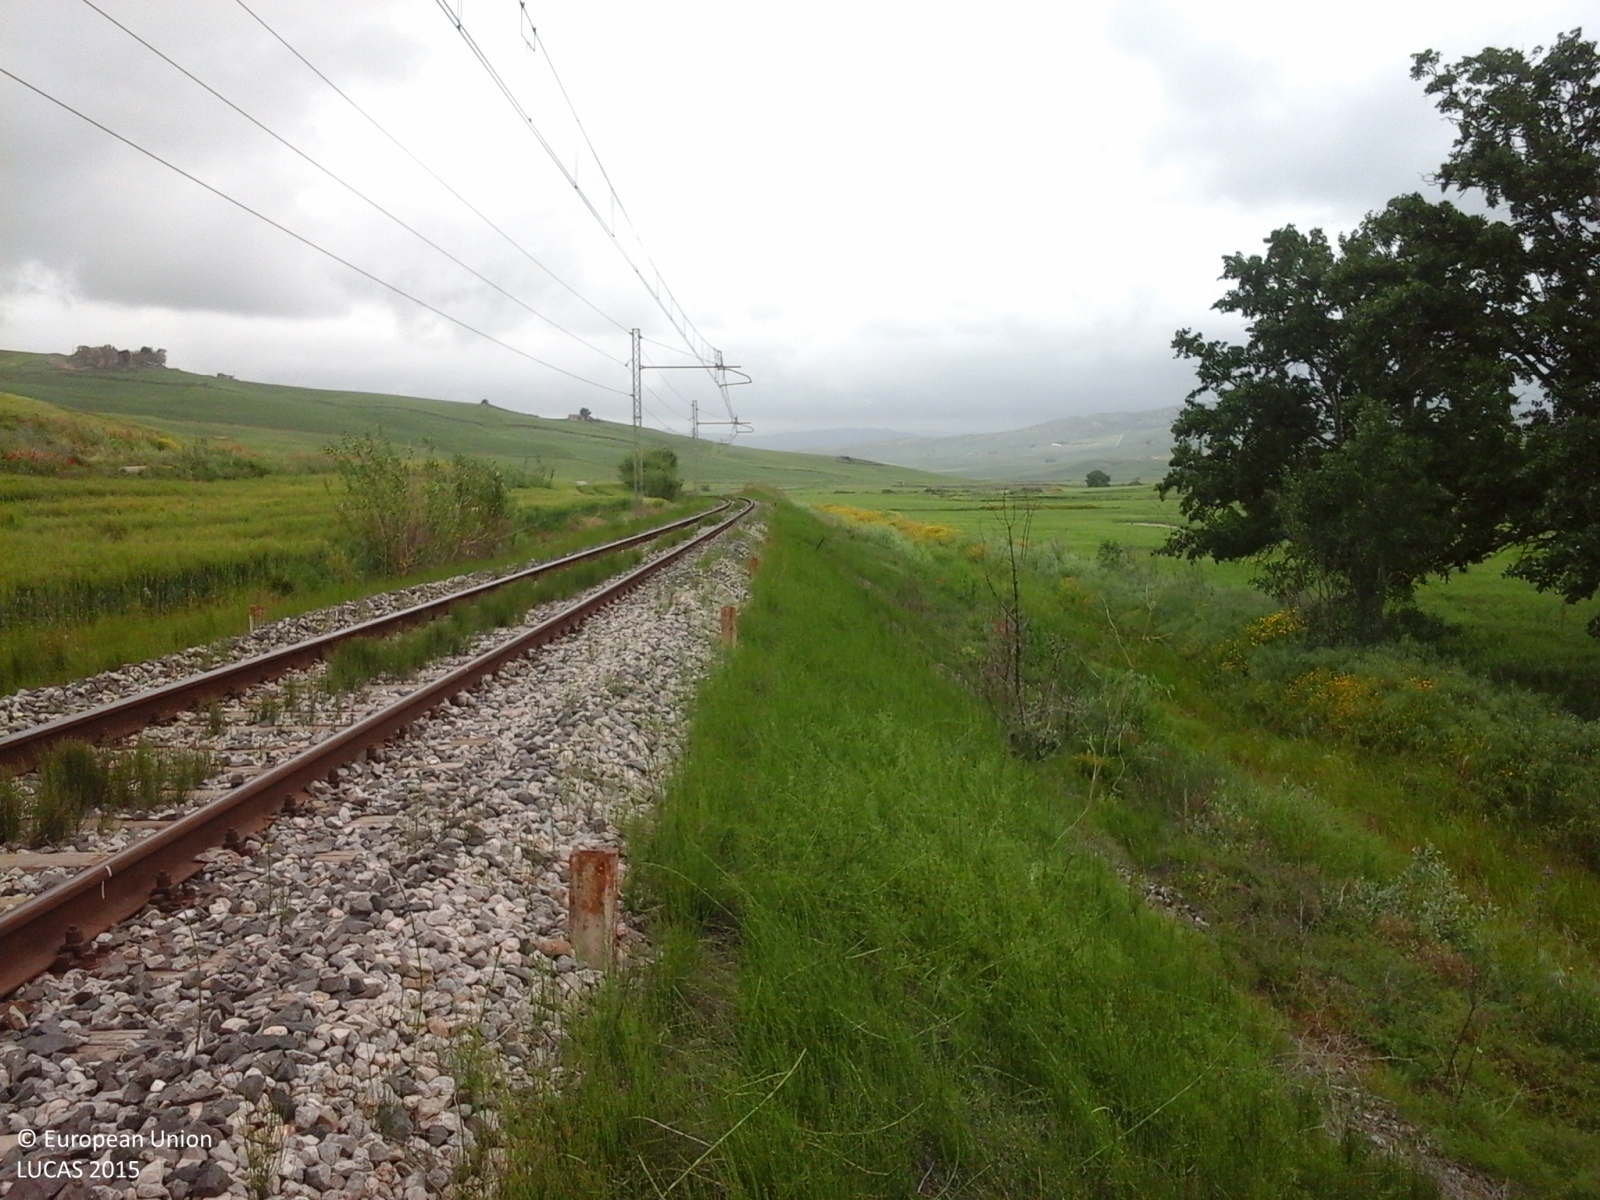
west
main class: Cropland
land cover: Durum wheat
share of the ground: > 75 %
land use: Agriculture (excluding fallow land and kitchen gardens)
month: May
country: IT
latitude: 37.7099
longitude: 13.7499
